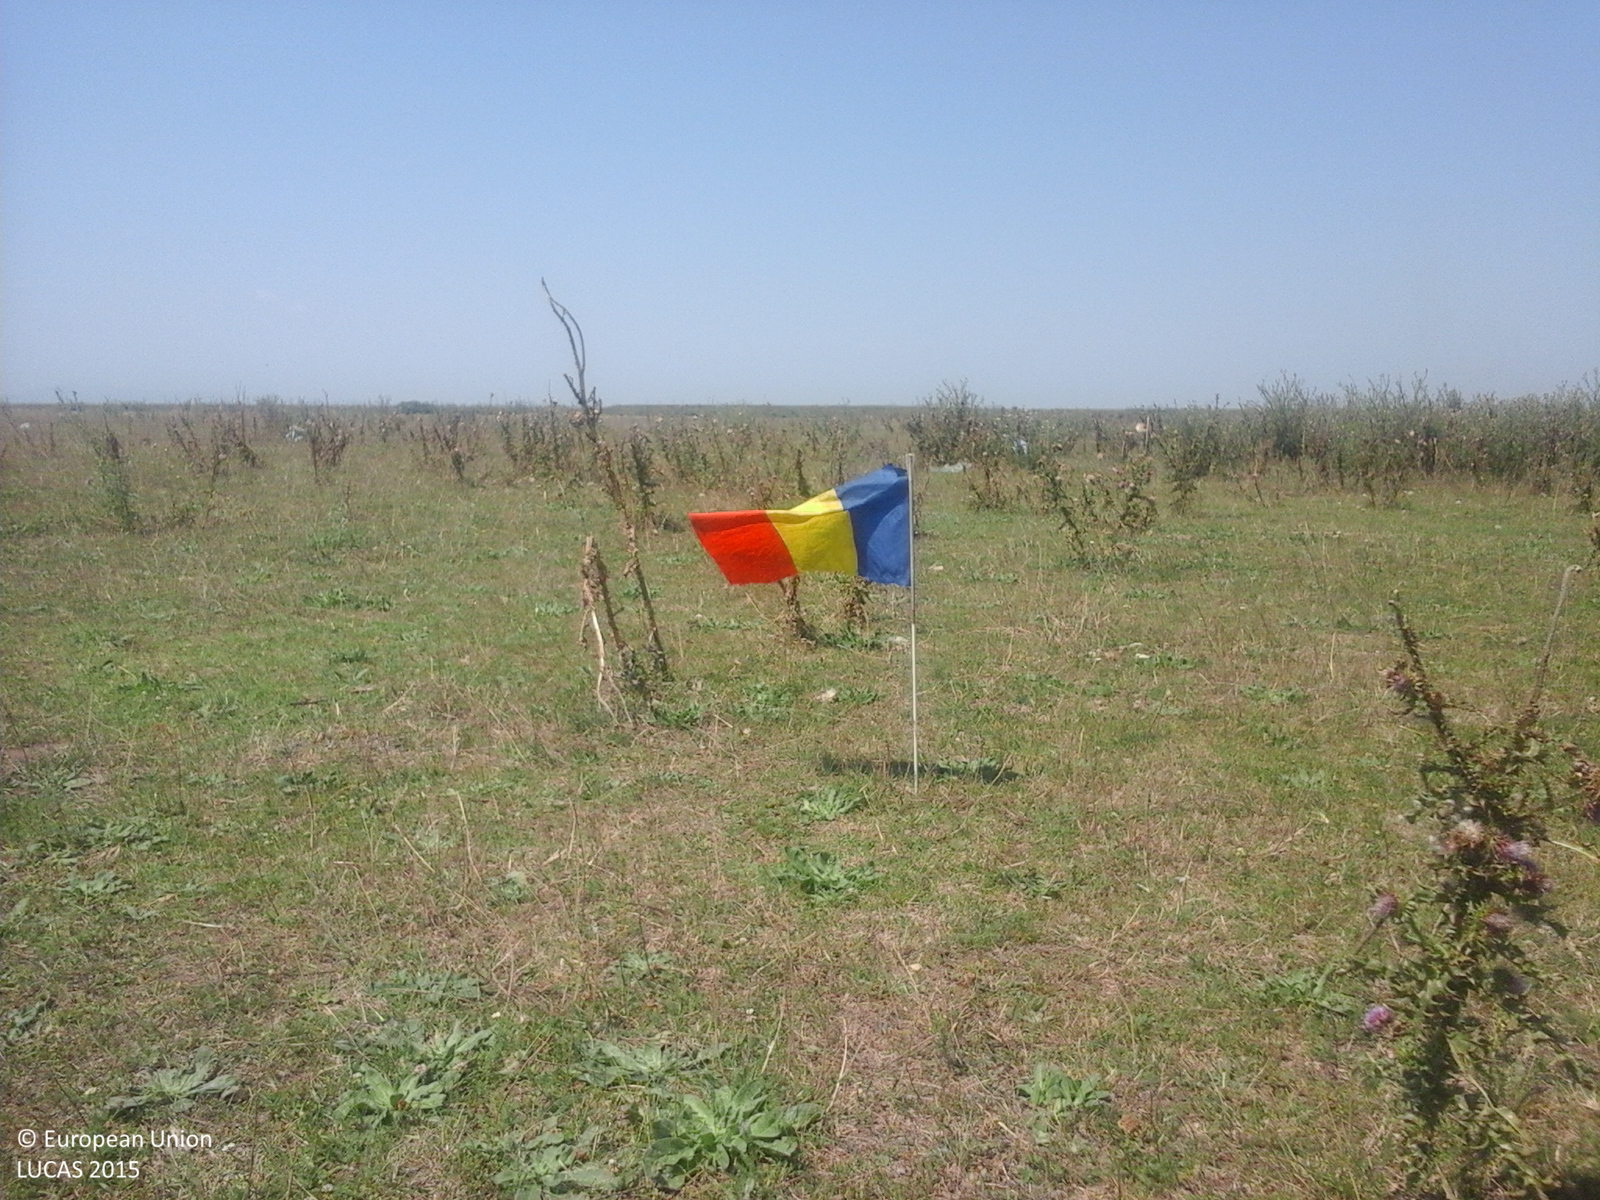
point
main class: Grassland
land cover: Grassland without tree/shrub cover
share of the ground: > 75 %
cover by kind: herbaceous plants 100 %
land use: Agriculture (excluding fallow land and kitchen gardens)
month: July
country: RO
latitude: 44.7804
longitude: 26.7435
